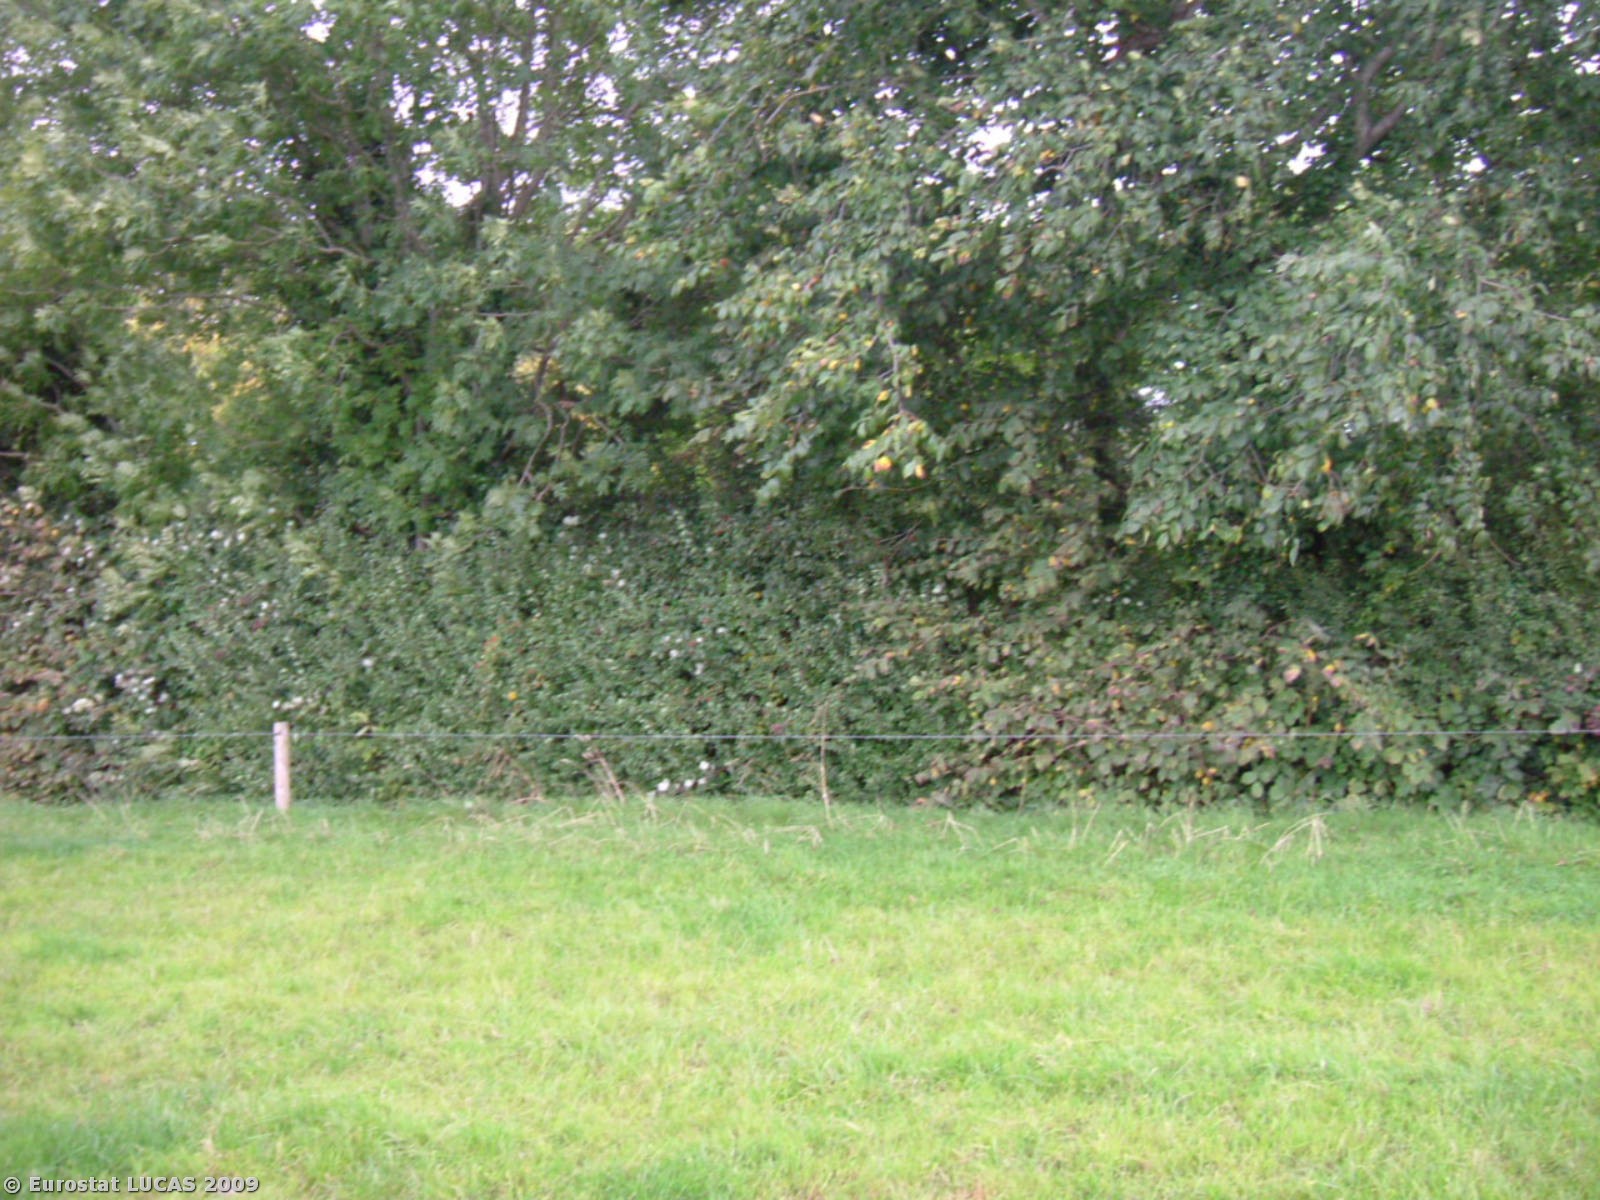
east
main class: Grassland
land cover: Grassland without tree/shrub cover
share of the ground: > 75 %
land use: Agriculture (excluding fallow land and kitchen gardens)
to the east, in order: Grassland without tree/shrub cover; Ditches and canals; Managed hedges; Grassland without tree/shrub cover; Ditches and canals; Managed hedges; Grassland without tree/shrub cover
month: September
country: IE
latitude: 52.8677
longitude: -8.2331
